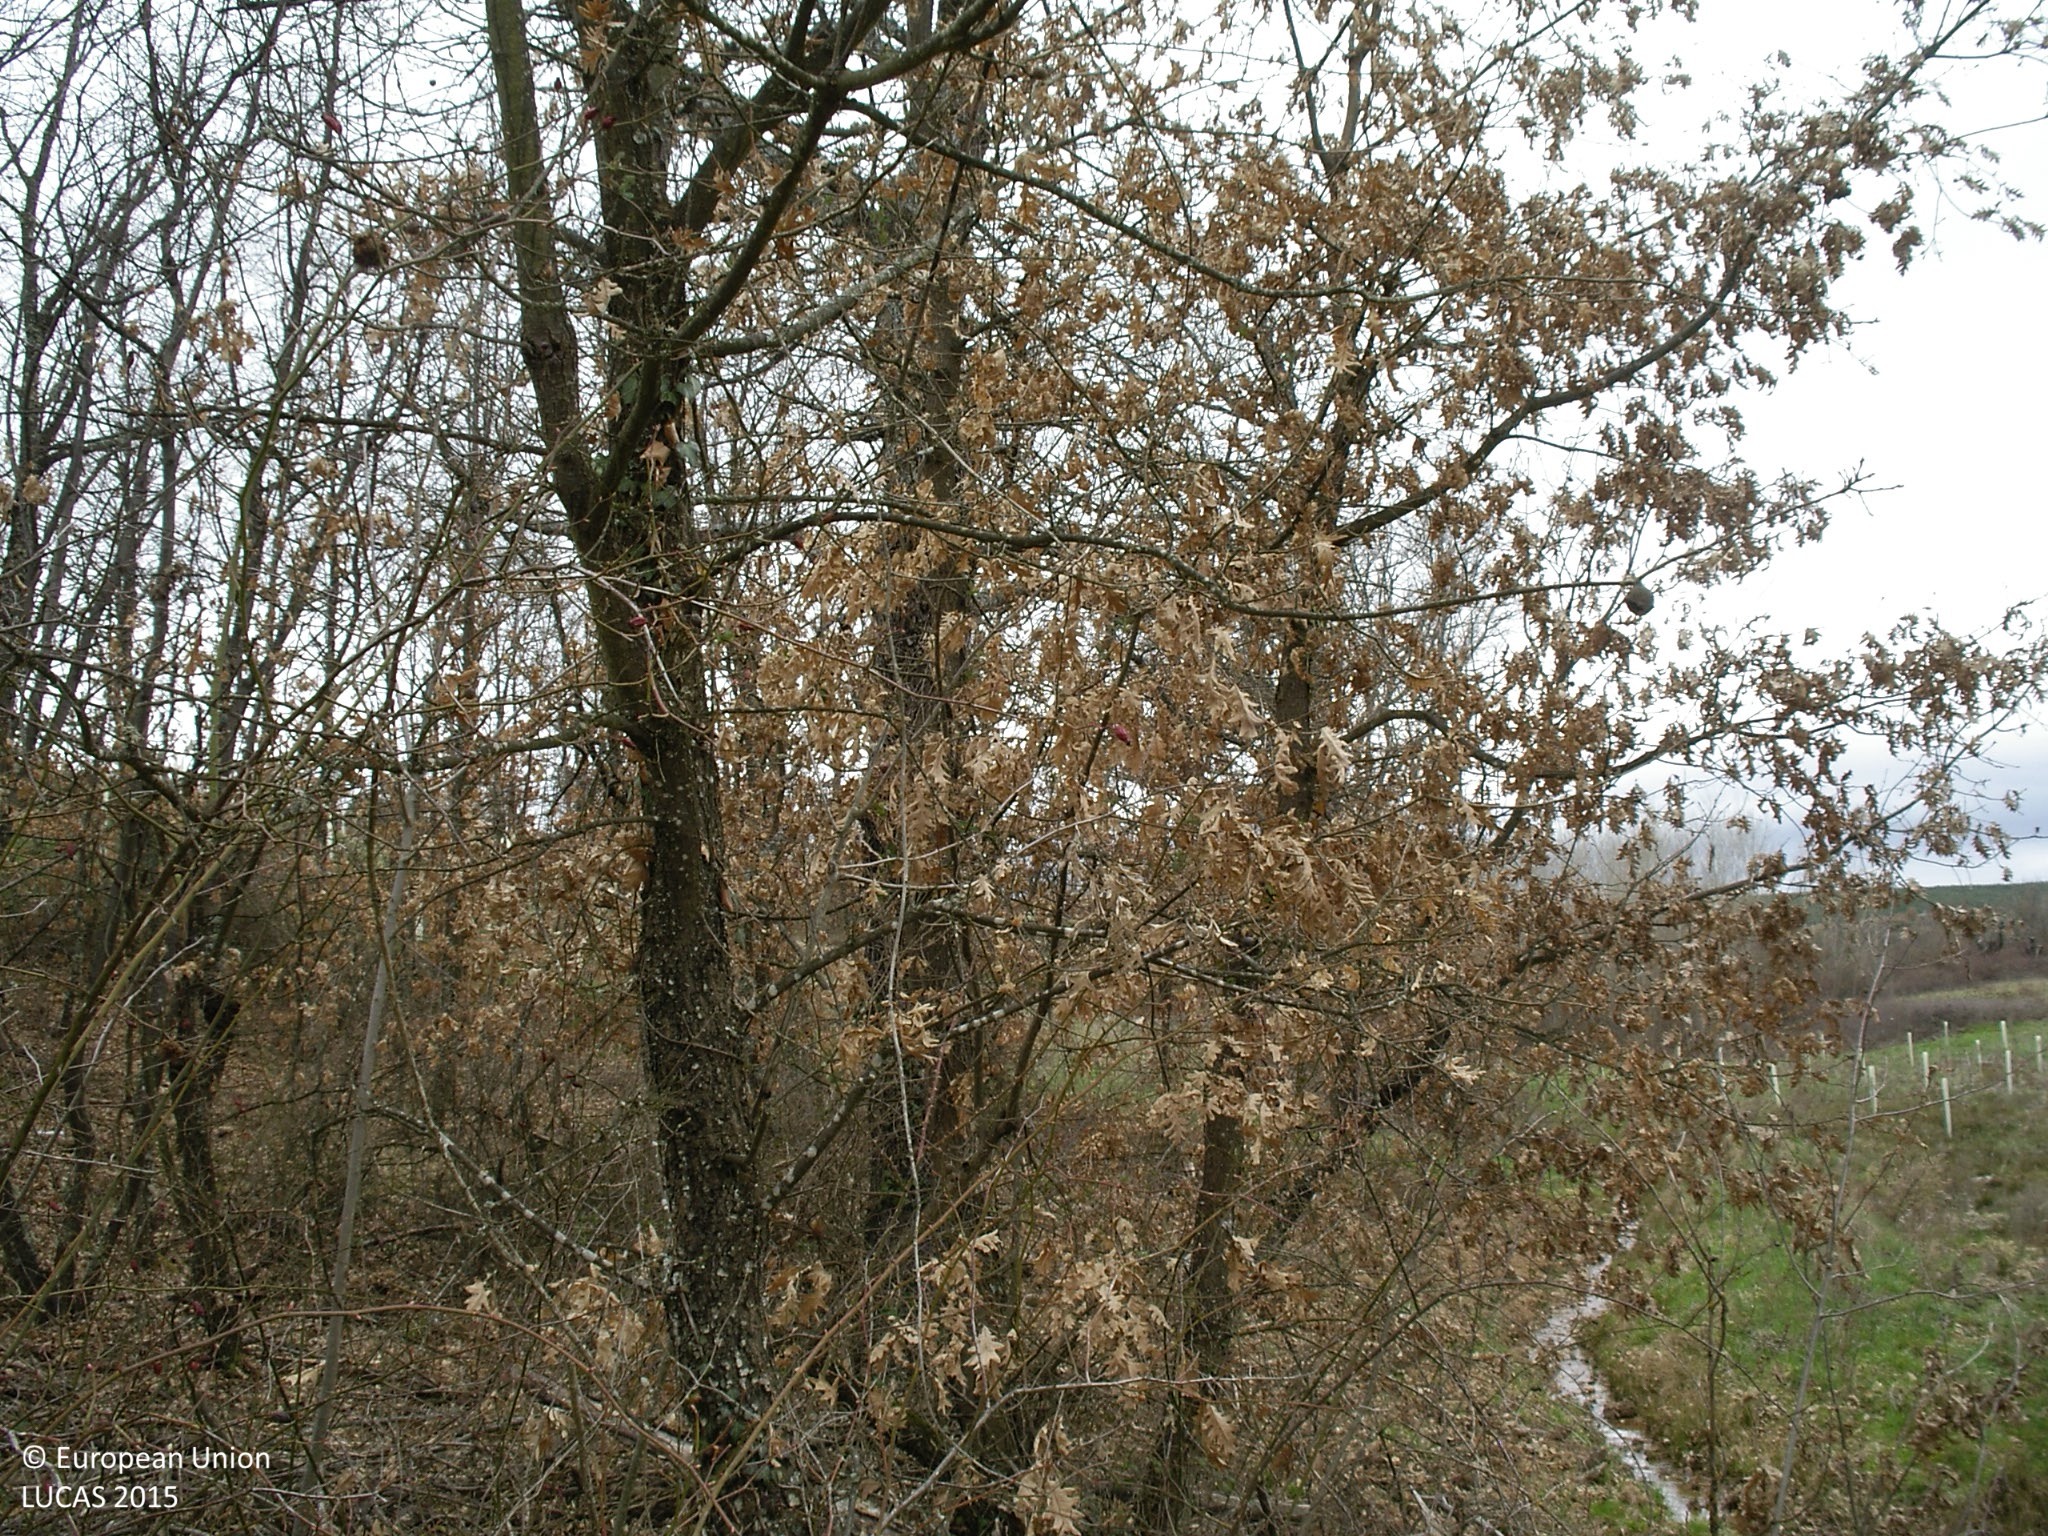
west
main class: Woodland
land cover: Broadleaved woodland
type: thermophilous deciduous forest
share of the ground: 25 - 50 %
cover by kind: herbaceous plants 55 %, broadleaved forest trees 30 %, shrubs 15 %
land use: Forestry
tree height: > 5 m
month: March
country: ES
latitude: 42.6411
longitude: -6.4477
